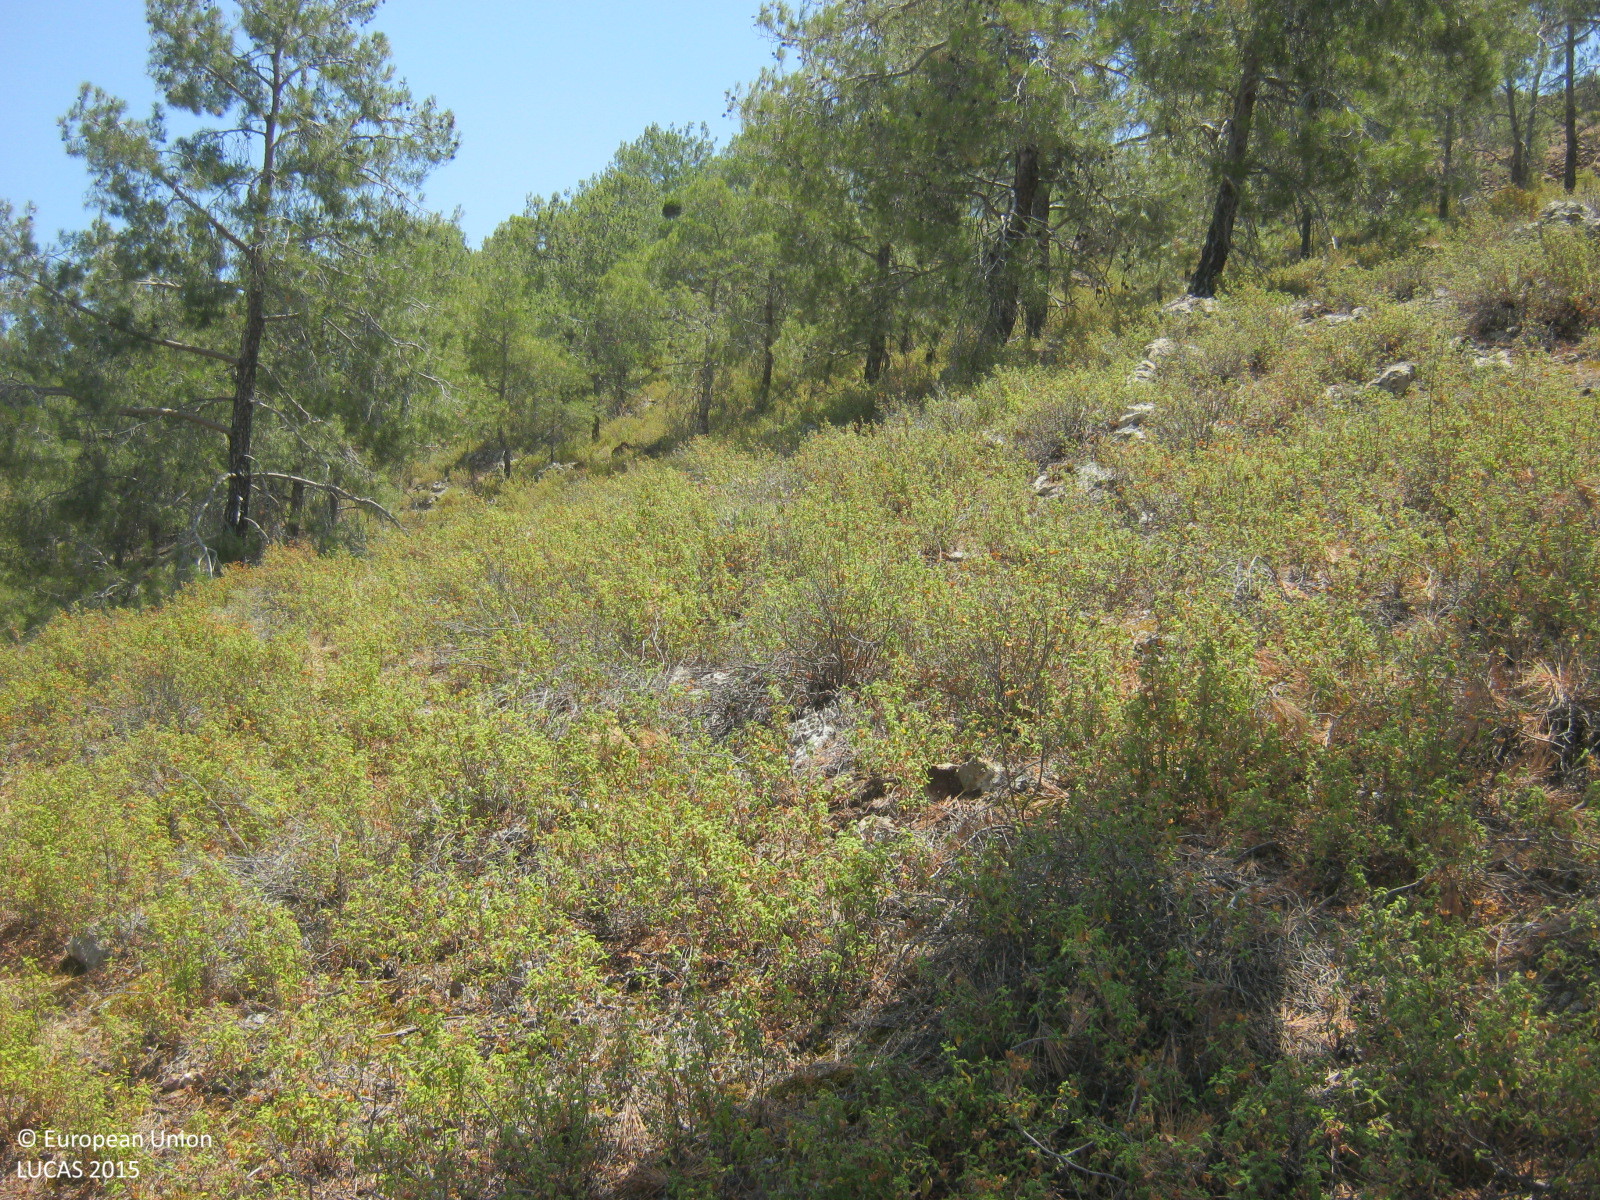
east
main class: Woodland
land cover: Pine dominated coniferous woodland
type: coniferous forest of the mediterranean region
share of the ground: 25 - 50 %
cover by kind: shrubs 55 %, coniferous forest trees 30 %, unconsolidated bare surface 10 %, consolidated bare surface 5 %
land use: Forestry
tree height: > 5 m
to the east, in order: Pine dominated coniferous woodland; Tracks; Pine dominated coniferous woodland; Dry stone walls; Pine dominated coniferous woodland
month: June
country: CY
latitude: 34.9979
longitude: 33.1557
